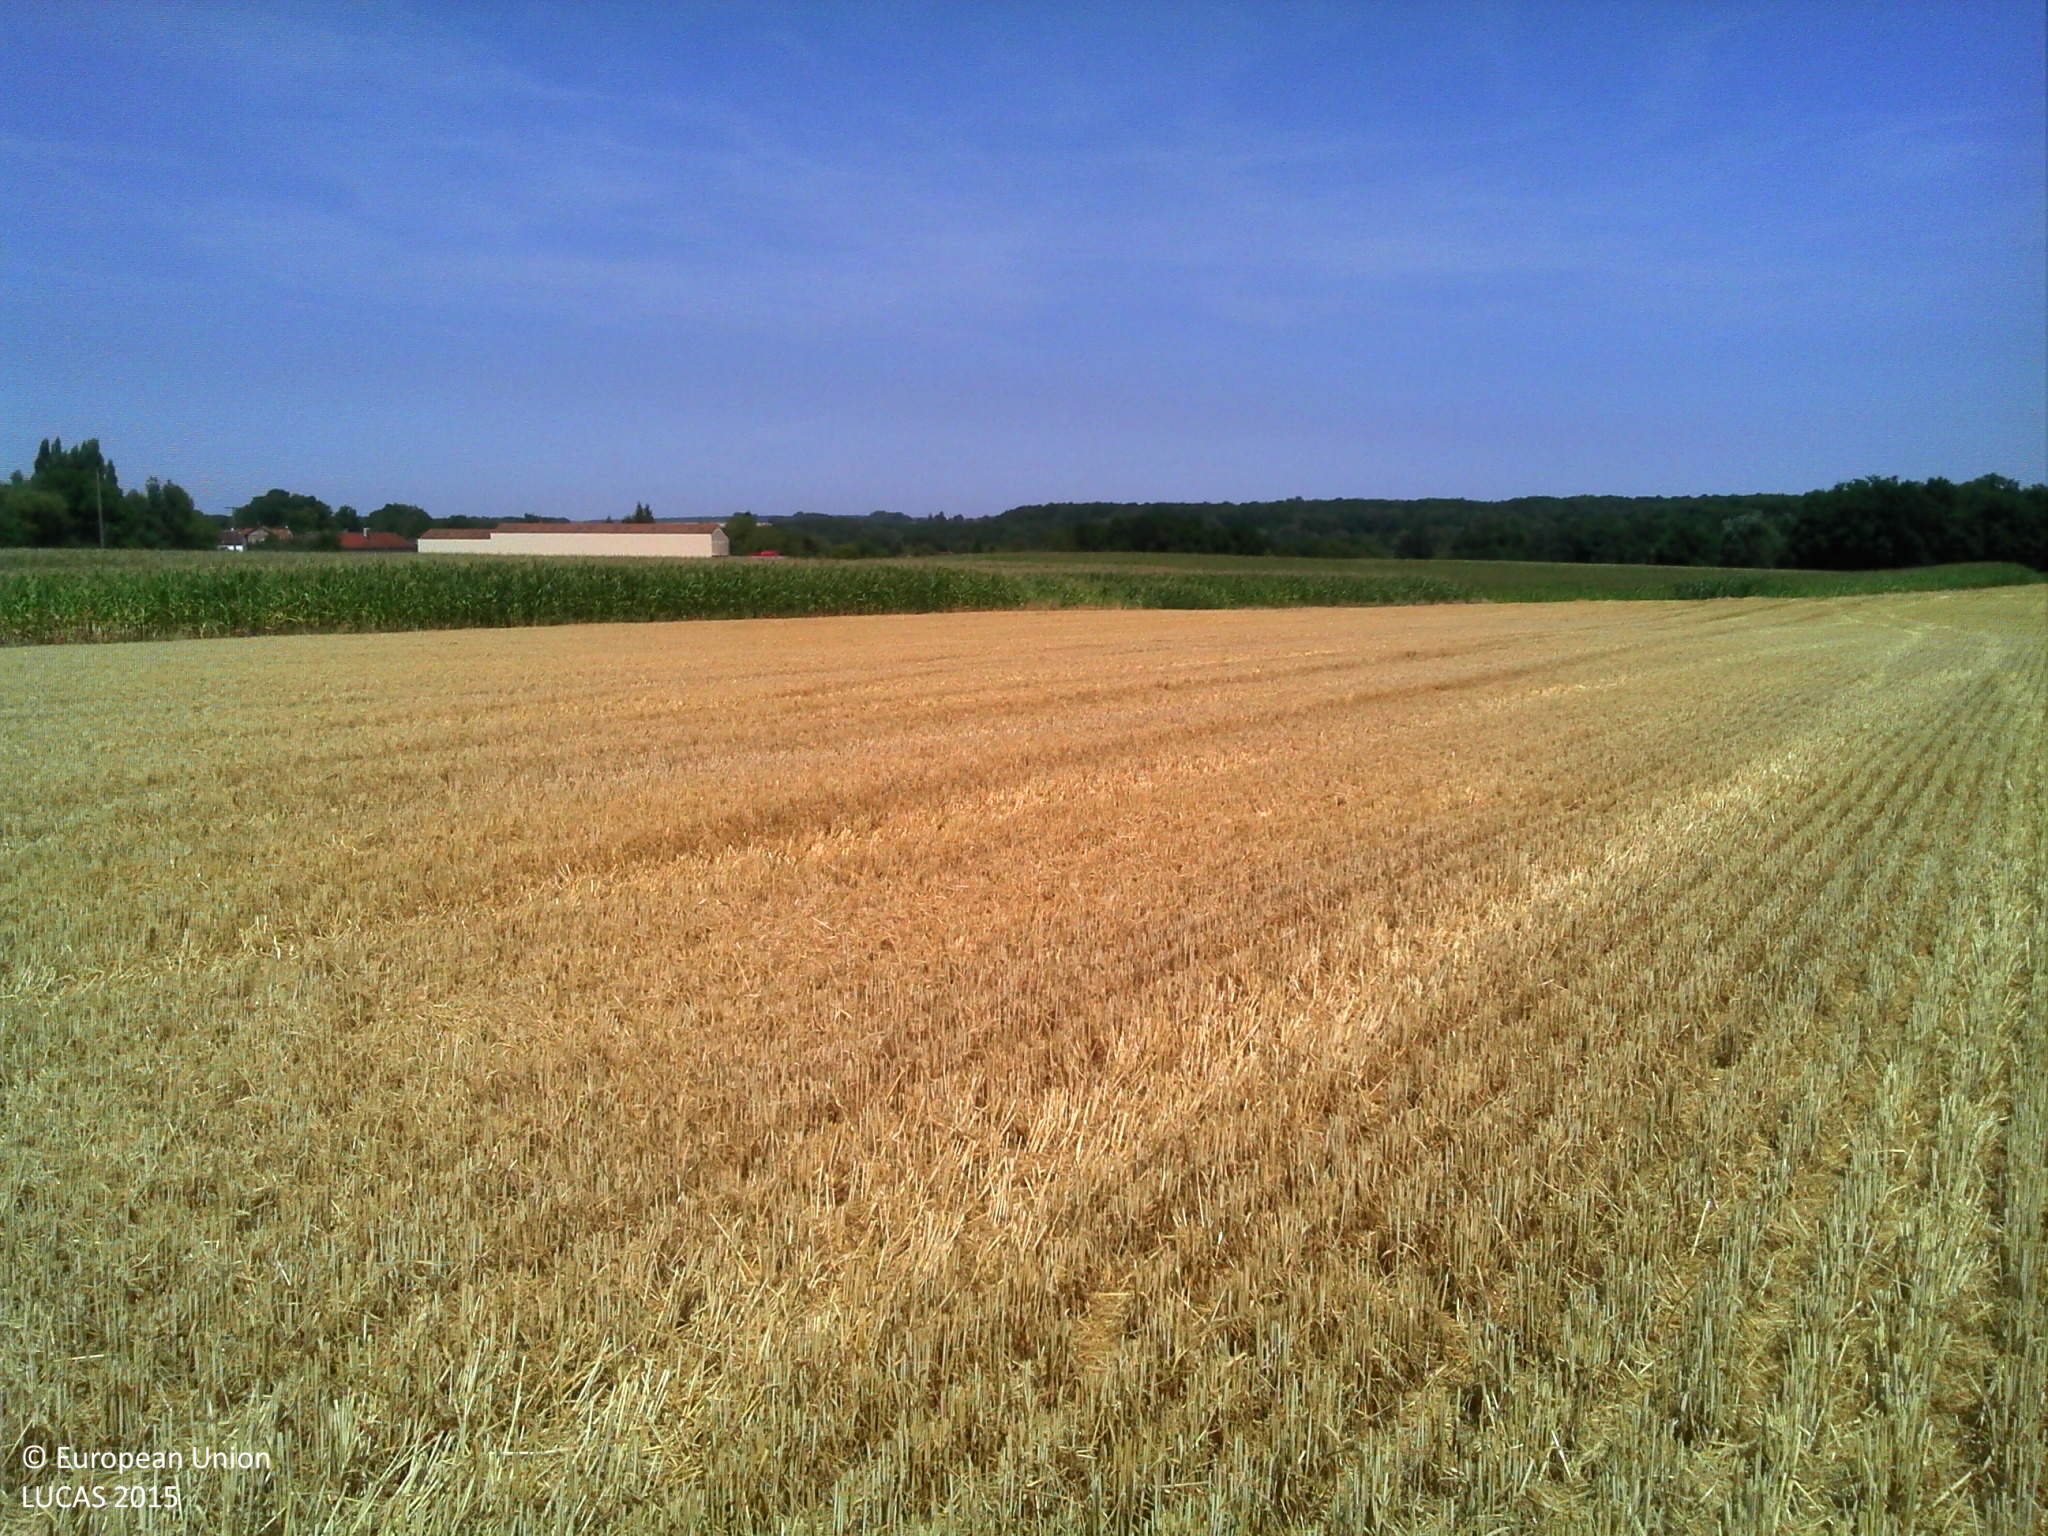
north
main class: Cropland
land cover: Barley
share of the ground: > 75 %
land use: Agriculture (excluding fallow land and kitchen gardens)
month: August
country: FR
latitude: 48.8339
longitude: 3.3309
